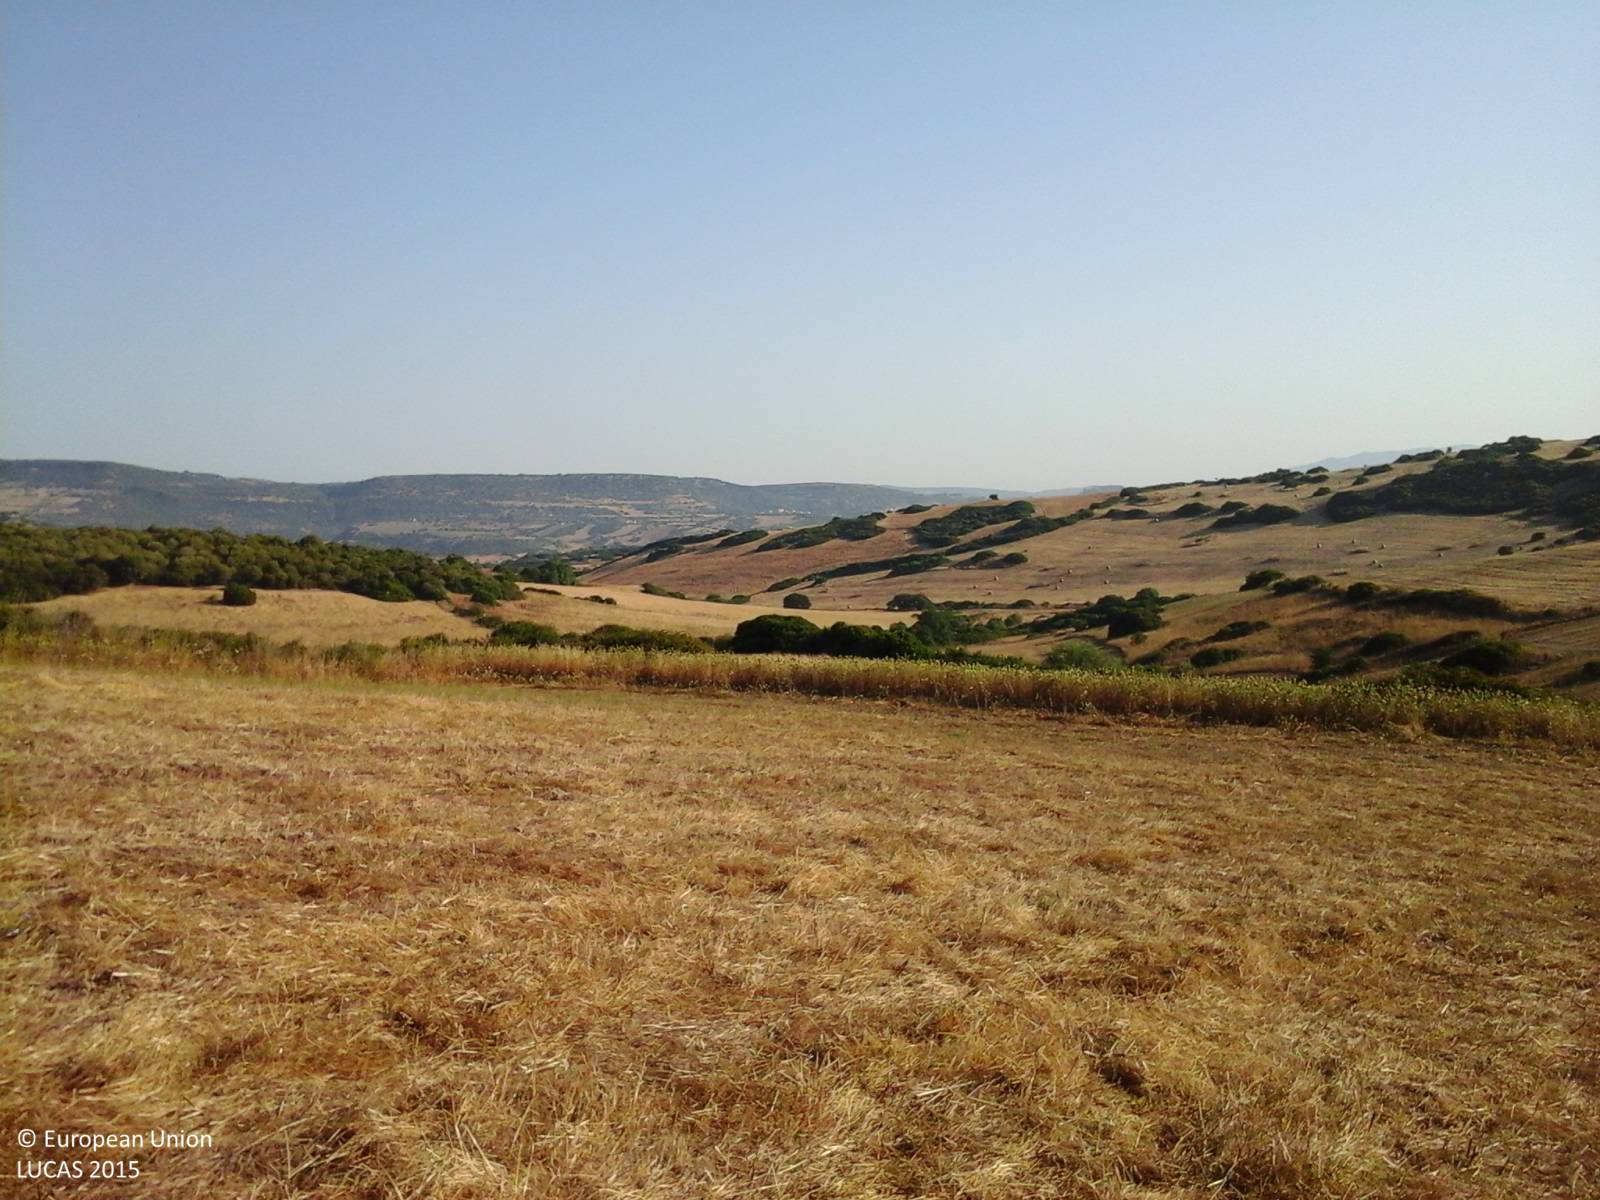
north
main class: Cropland
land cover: Oats
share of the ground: > 75 %
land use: Agriculture (excluding fallow land and kitchen gardens)
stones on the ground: < 10 %
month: July
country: IT
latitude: 40.7672
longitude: 8.8328
